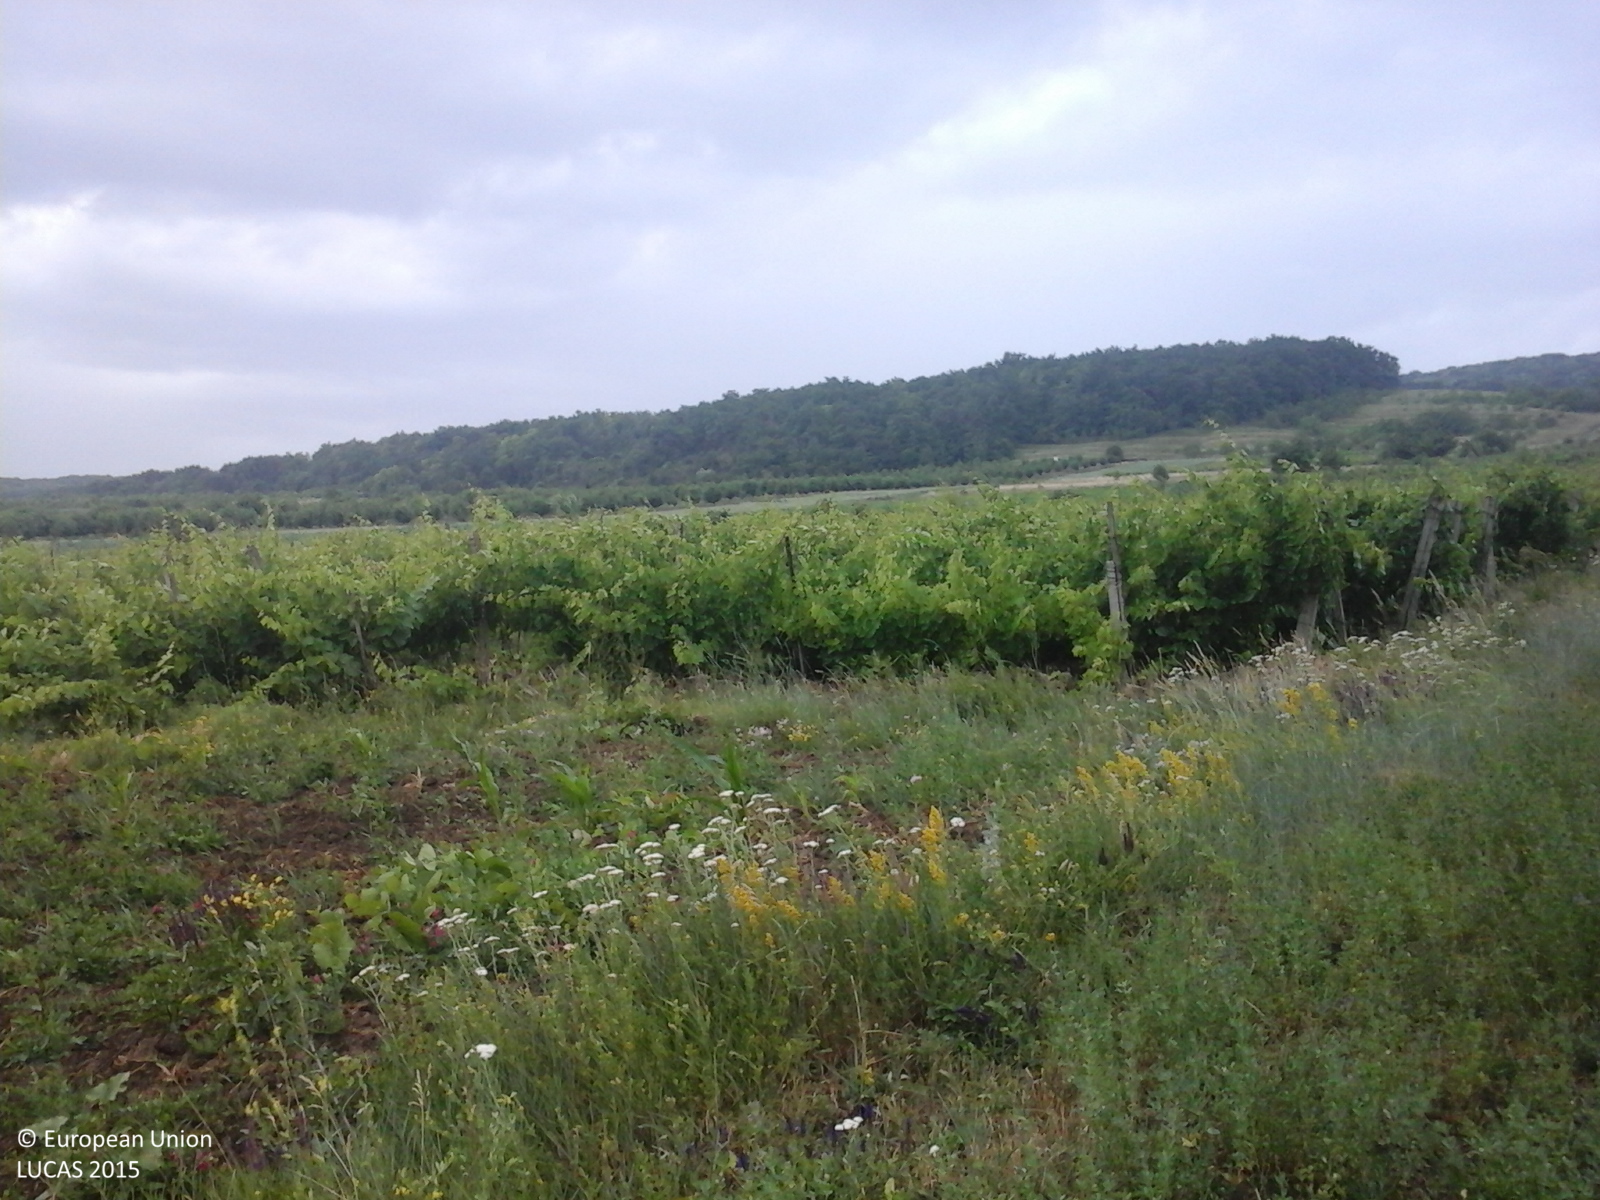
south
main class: Cropland
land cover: Lucerne
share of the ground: > 75 %
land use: Agriculture (excluding fallow land and kitchen gardens)
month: June
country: RO
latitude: 47.3261
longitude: 26.9170
